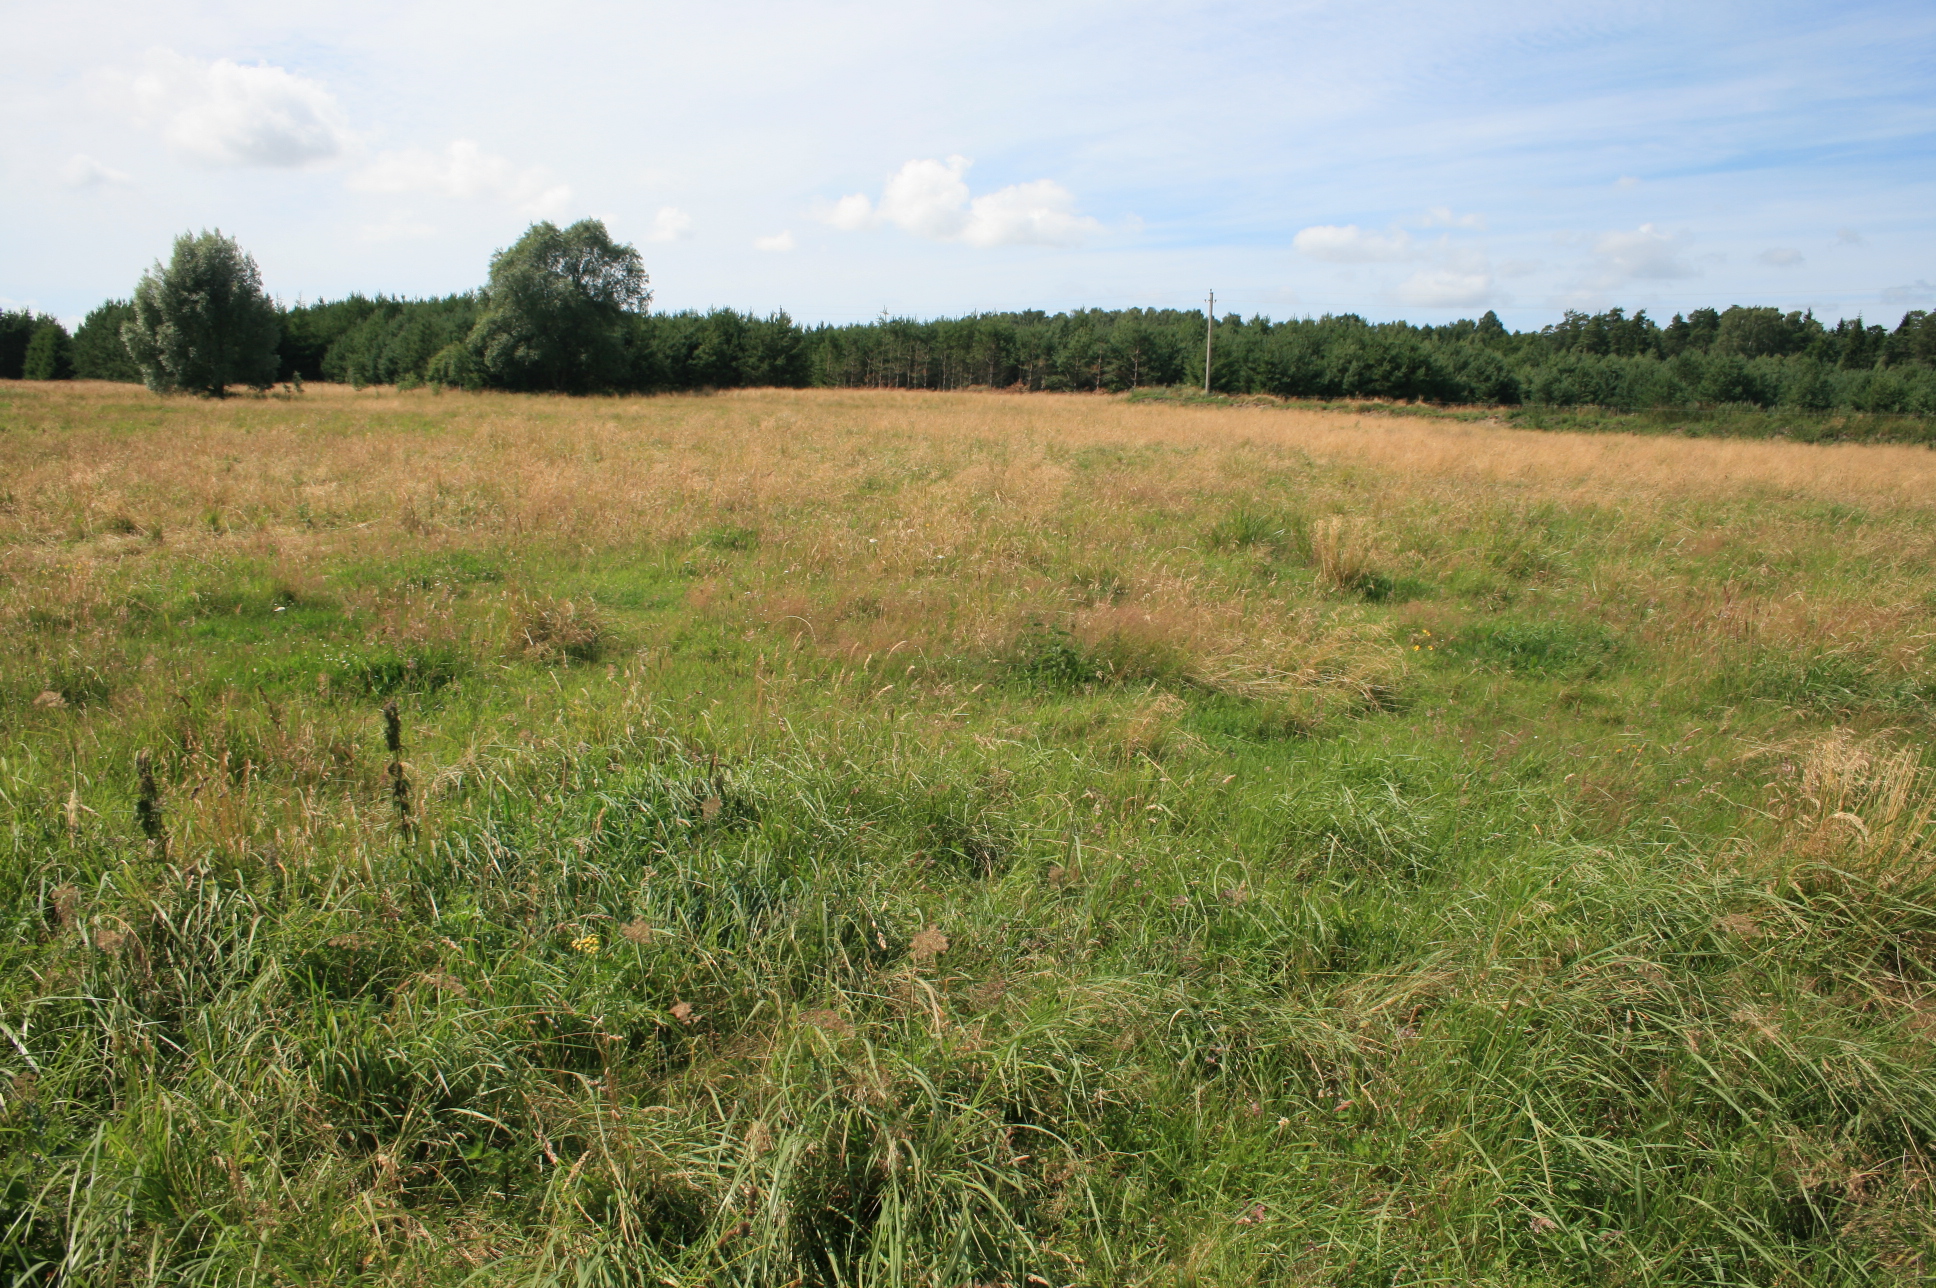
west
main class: Grassland
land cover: Grassland without tree/shrub cover
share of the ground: > 75 %
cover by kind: herbaceous plants 100 %
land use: Agriculture (excluding fallow land and kitchen gardens)
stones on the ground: < 10 %
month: July
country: LT
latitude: 55.5433
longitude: 21.2790
